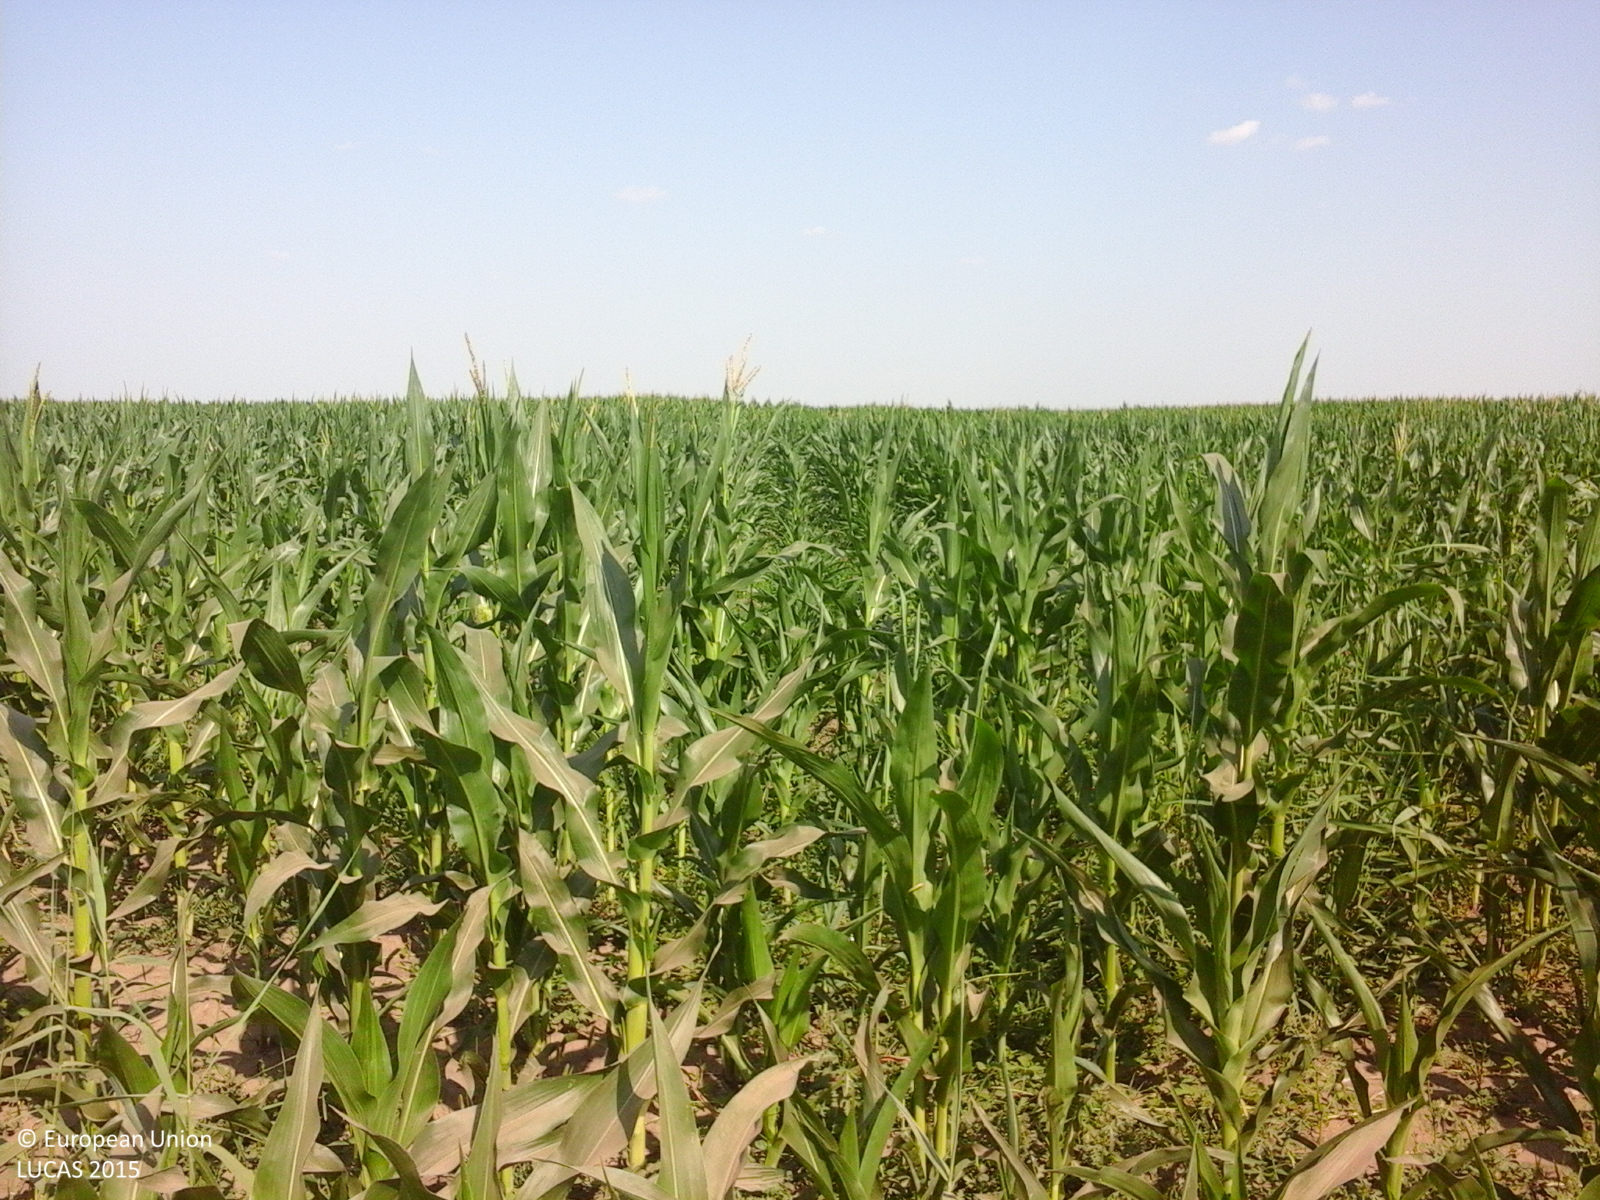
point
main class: Cropland
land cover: Maize
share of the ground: > 75 %
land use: Agriculture (excluding fallow land and kitchen gardens)
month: July
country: RO
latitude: 45.0443
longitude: 26.9290
